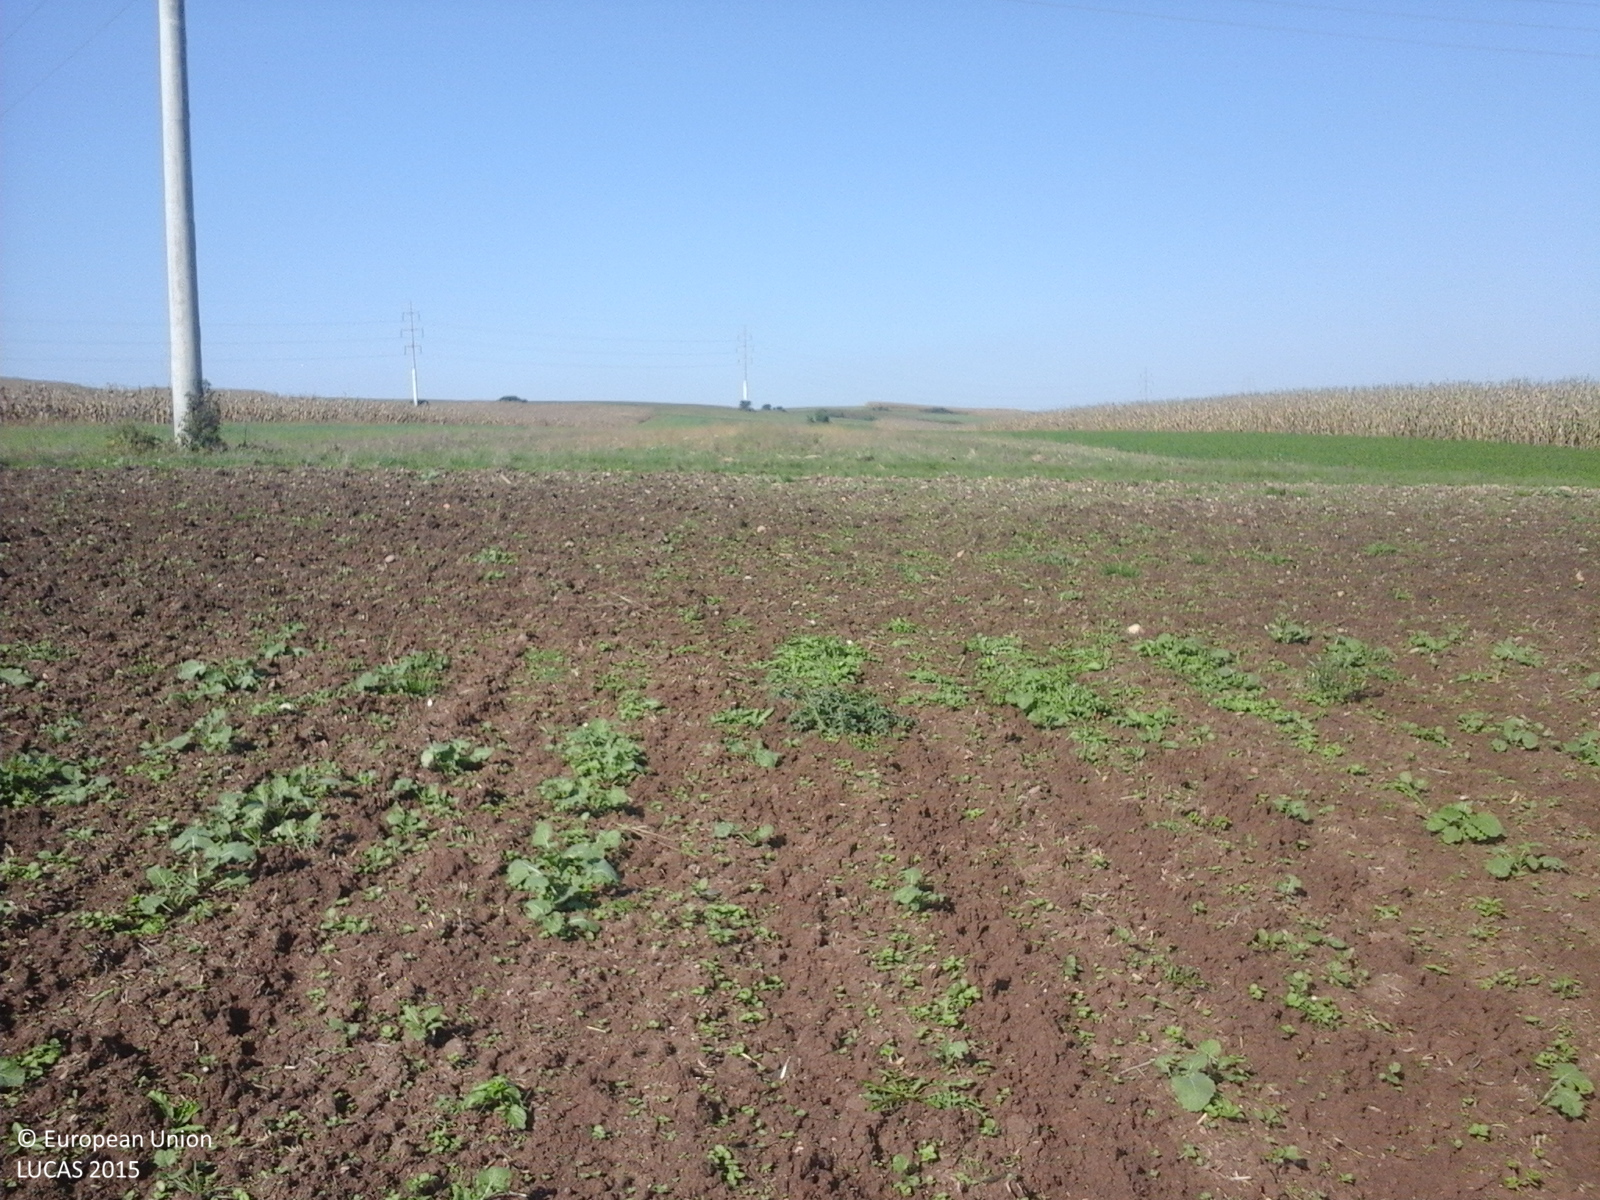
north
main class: Cropland
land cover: Common wheat
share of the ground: < 10 %
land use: Agriculture (excluding fallow land and kitchen gardens)
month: October
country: RO
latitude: 46.4018
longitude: 23.7946
